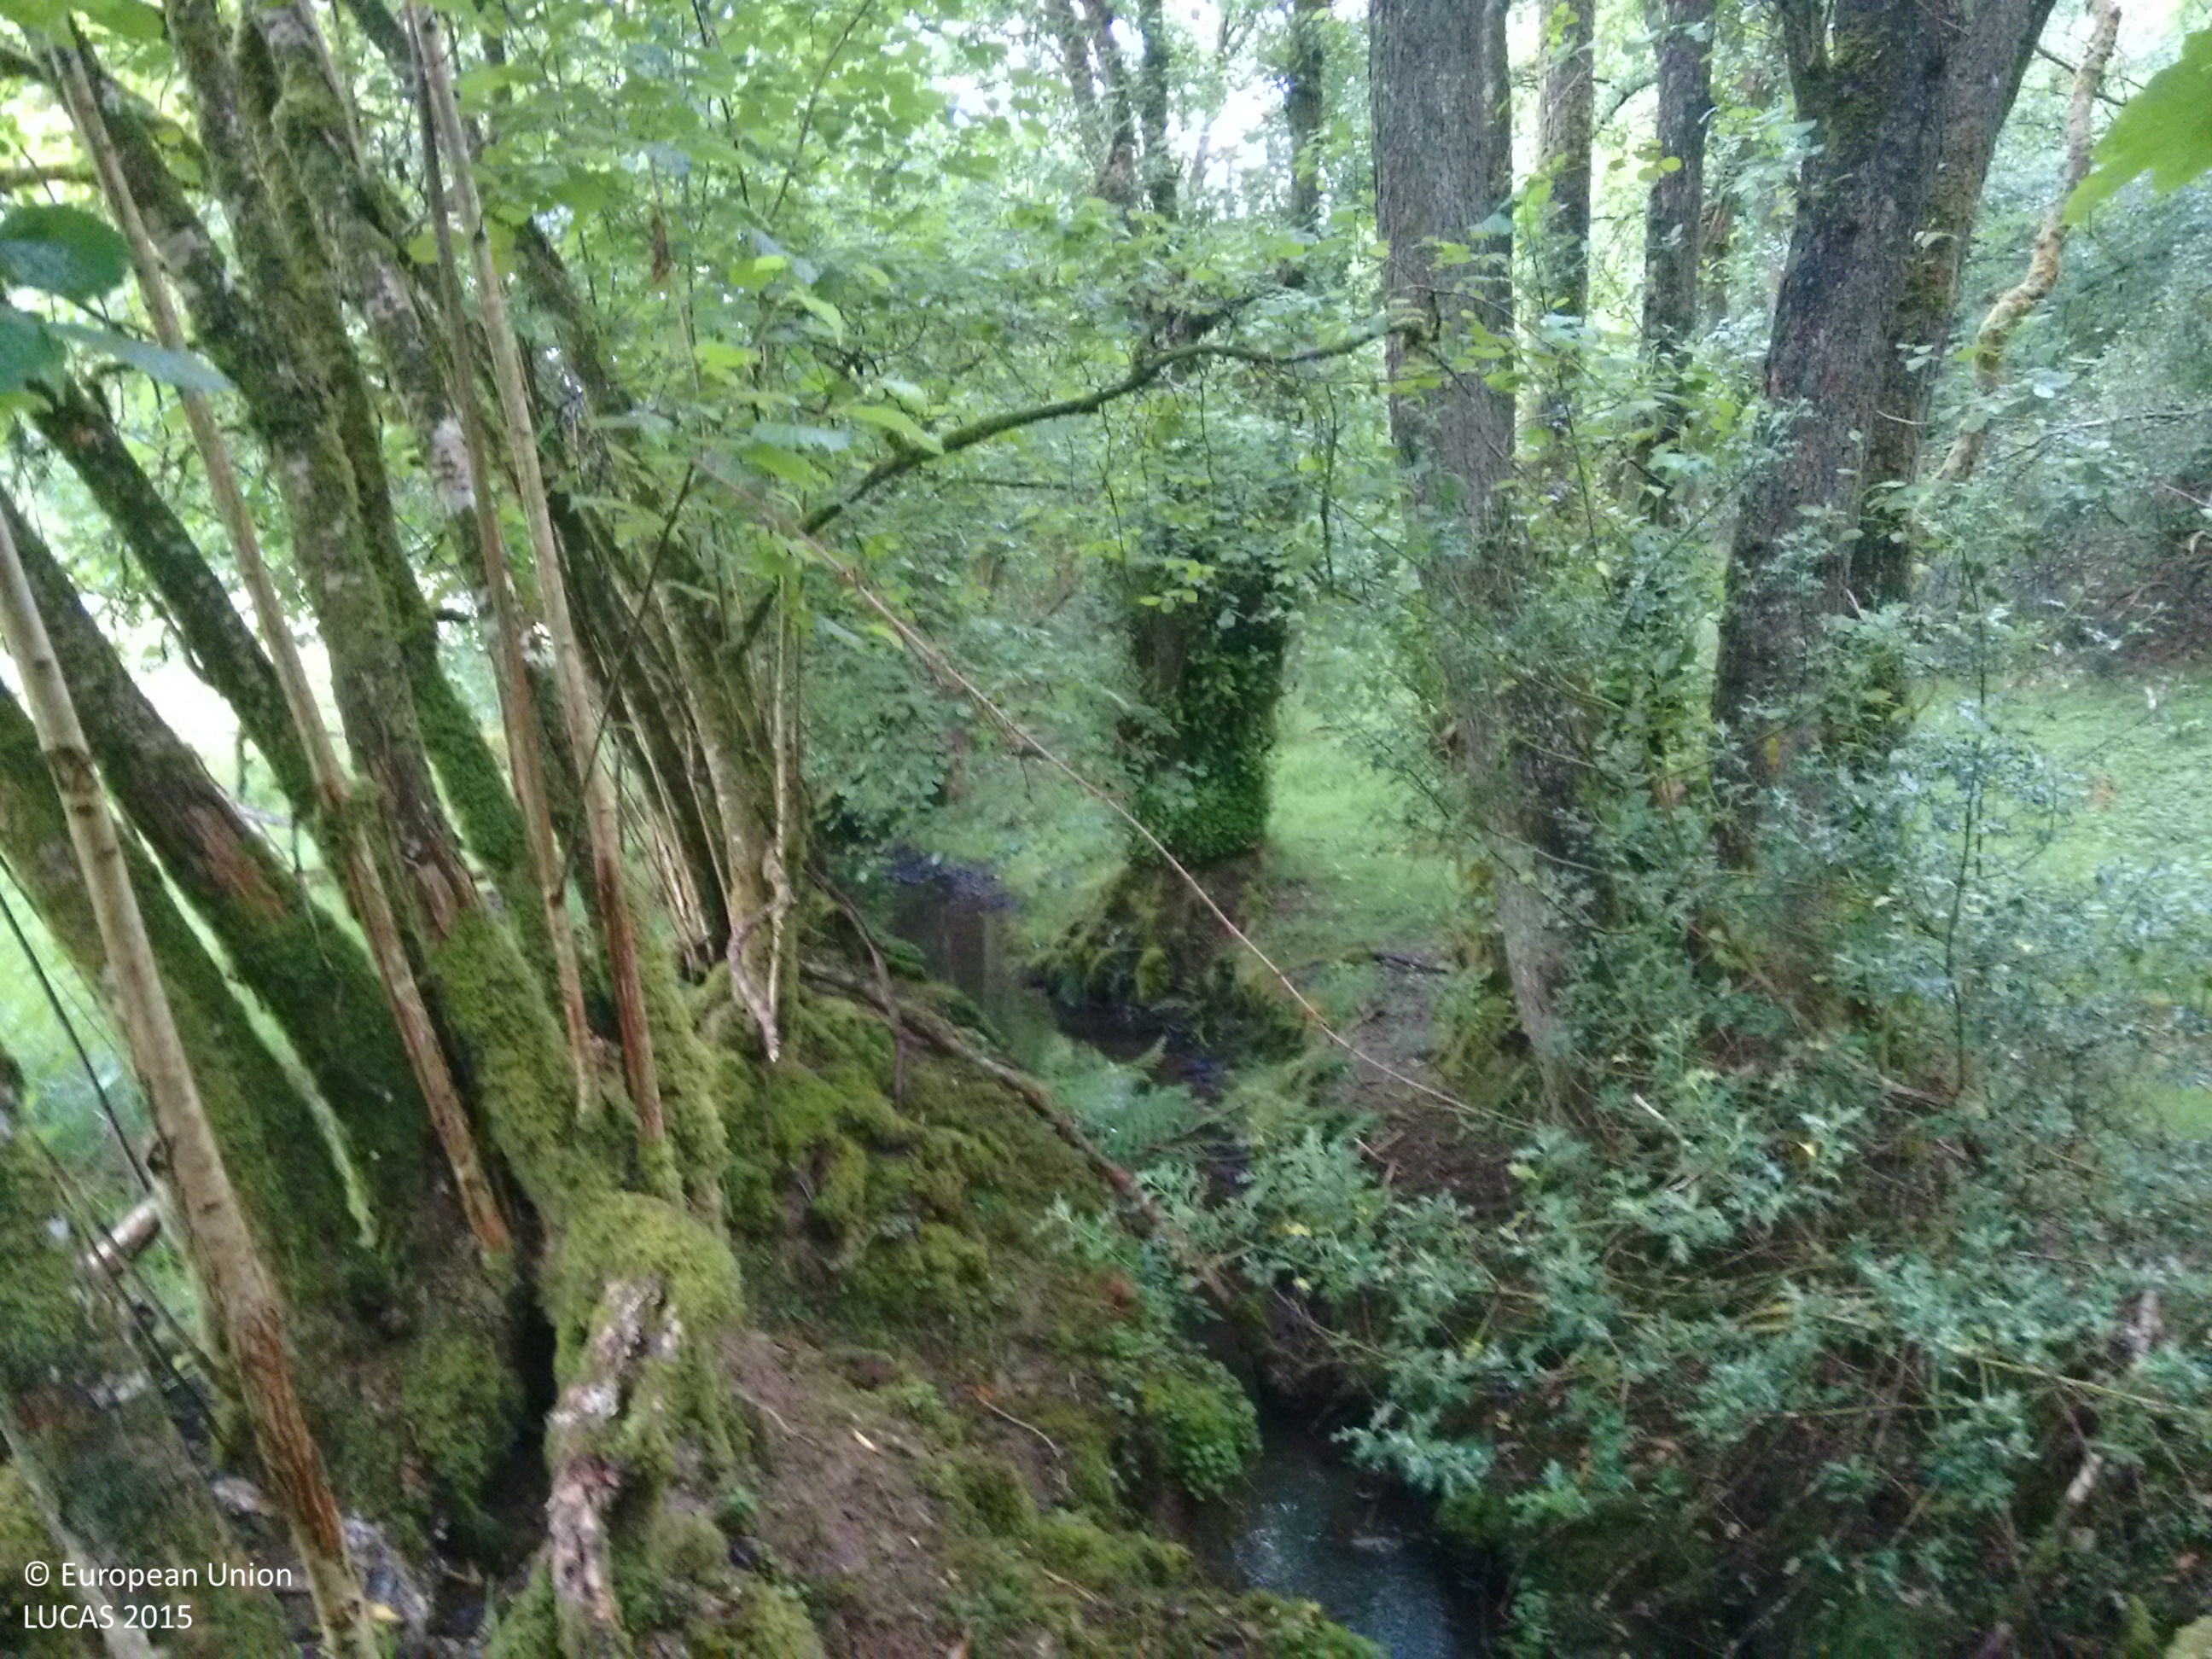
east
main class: Woodland
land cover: Broadleaved woodland
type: mesophytic deciduous forest
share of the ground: > 75 %
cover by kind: broadleaved forest trees 100 %
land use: Semi-natural and natural areas not in use
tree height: > 5 m
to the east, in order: Broadleaved woodland; Rivers and streams; Broadleaved woodland; Fences; Broadleaved woodland; Rivers and streams; Broadleaved woodland; Fences; Broadleaved woodland; Grassland without tree/shrub cover
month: July
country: GB
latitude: 51.0115
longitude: -3.5546
